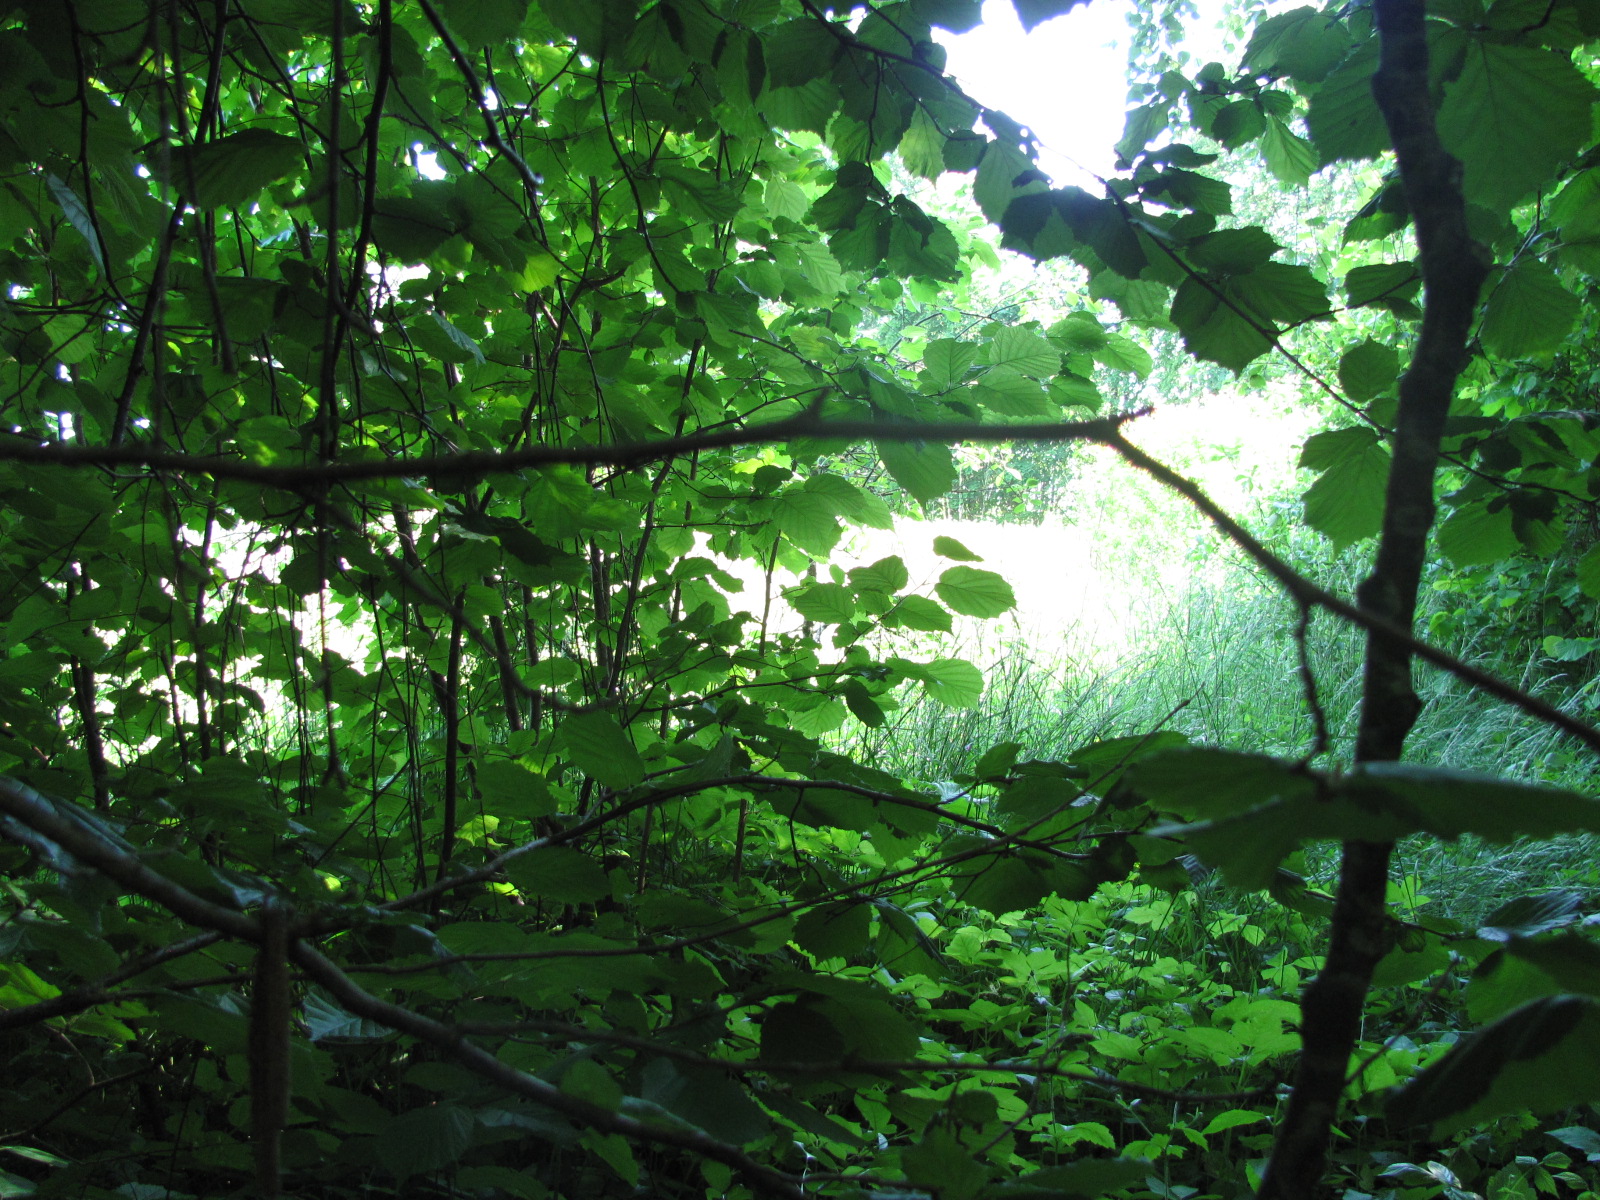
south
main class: Woodland
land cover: Broadleaved woodland
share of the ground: > 75 %
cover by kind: broadleaved forest trees 100 %
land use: Residential
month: June
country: LV
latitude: 56.4475
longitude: 24.2533
